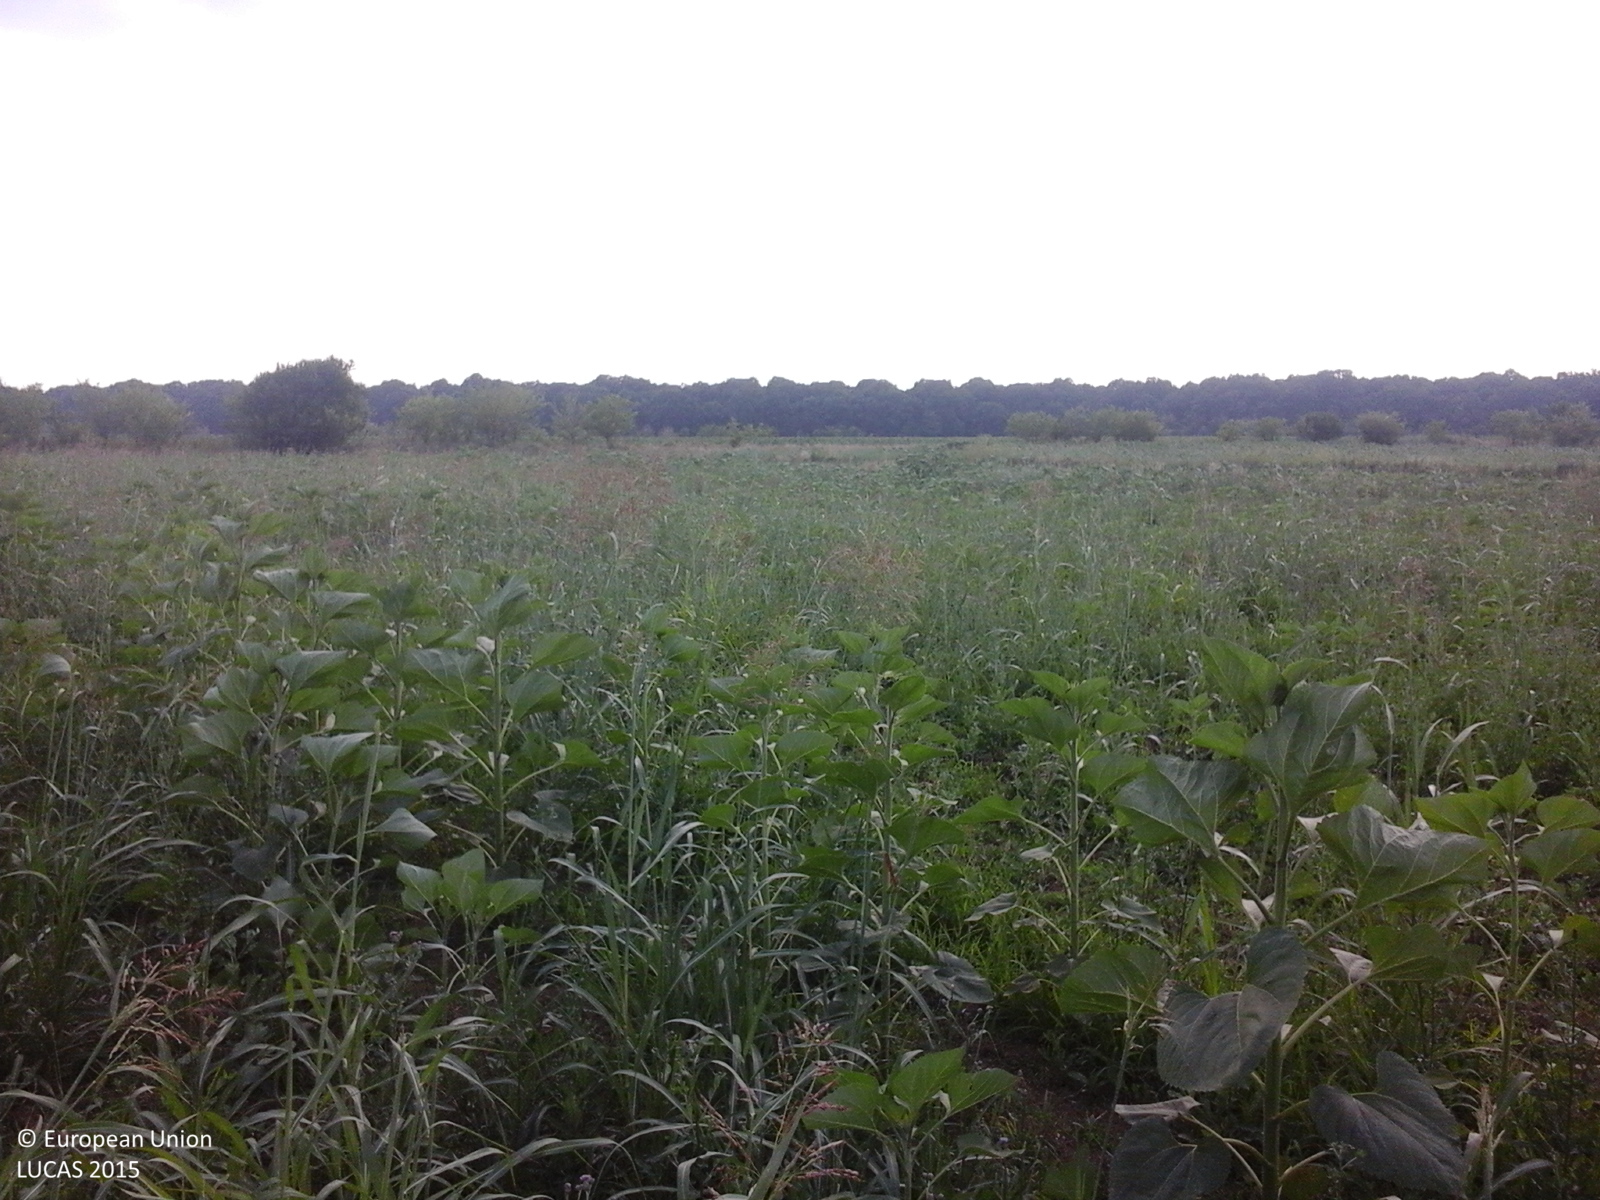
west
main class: Cropland
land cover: Sunflower
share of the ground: 25 - 50 %
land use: Agriculture (excluding fallow land and kitchen gardens)
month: July
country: RO
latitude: 43.8626
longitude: 24.7137
